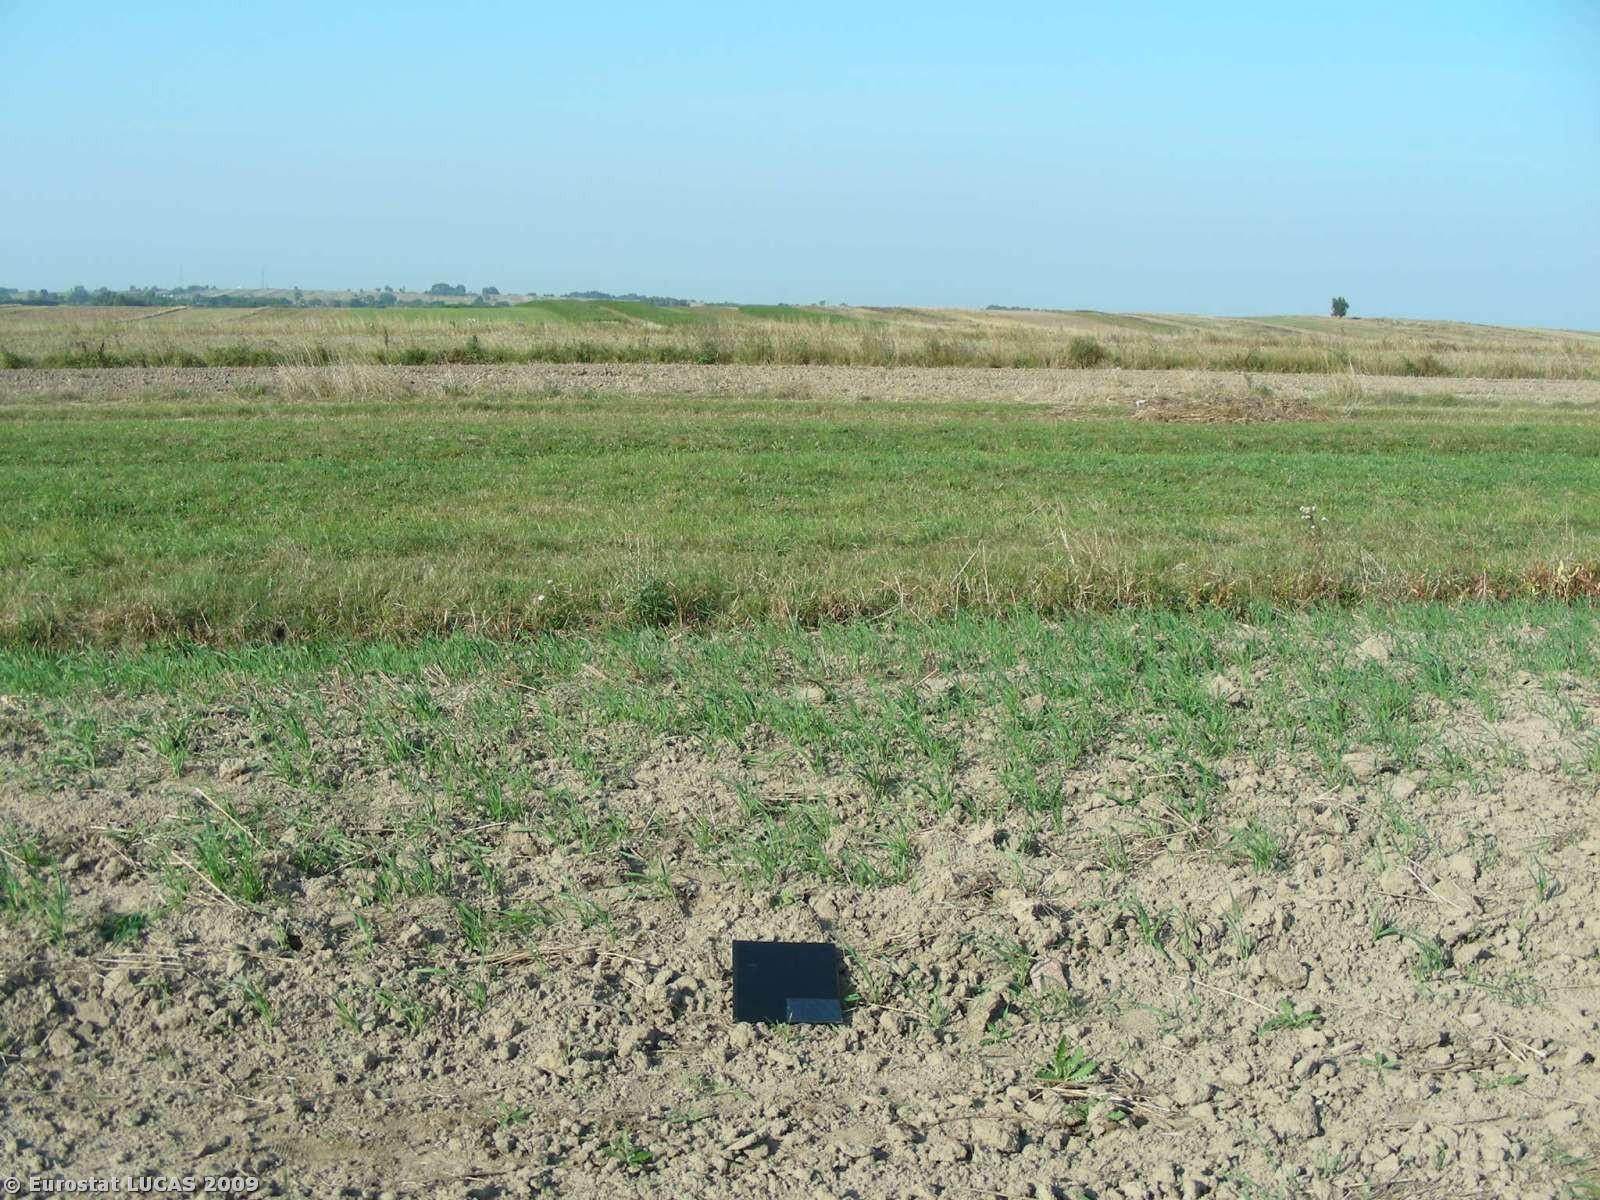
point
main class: Cropland
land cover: Potatoes
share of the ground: < 10 %
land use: Agriculture (excluding fallow land and kitchen gardens)
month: September
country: PL
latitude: 50.3519
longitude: 22.1325
